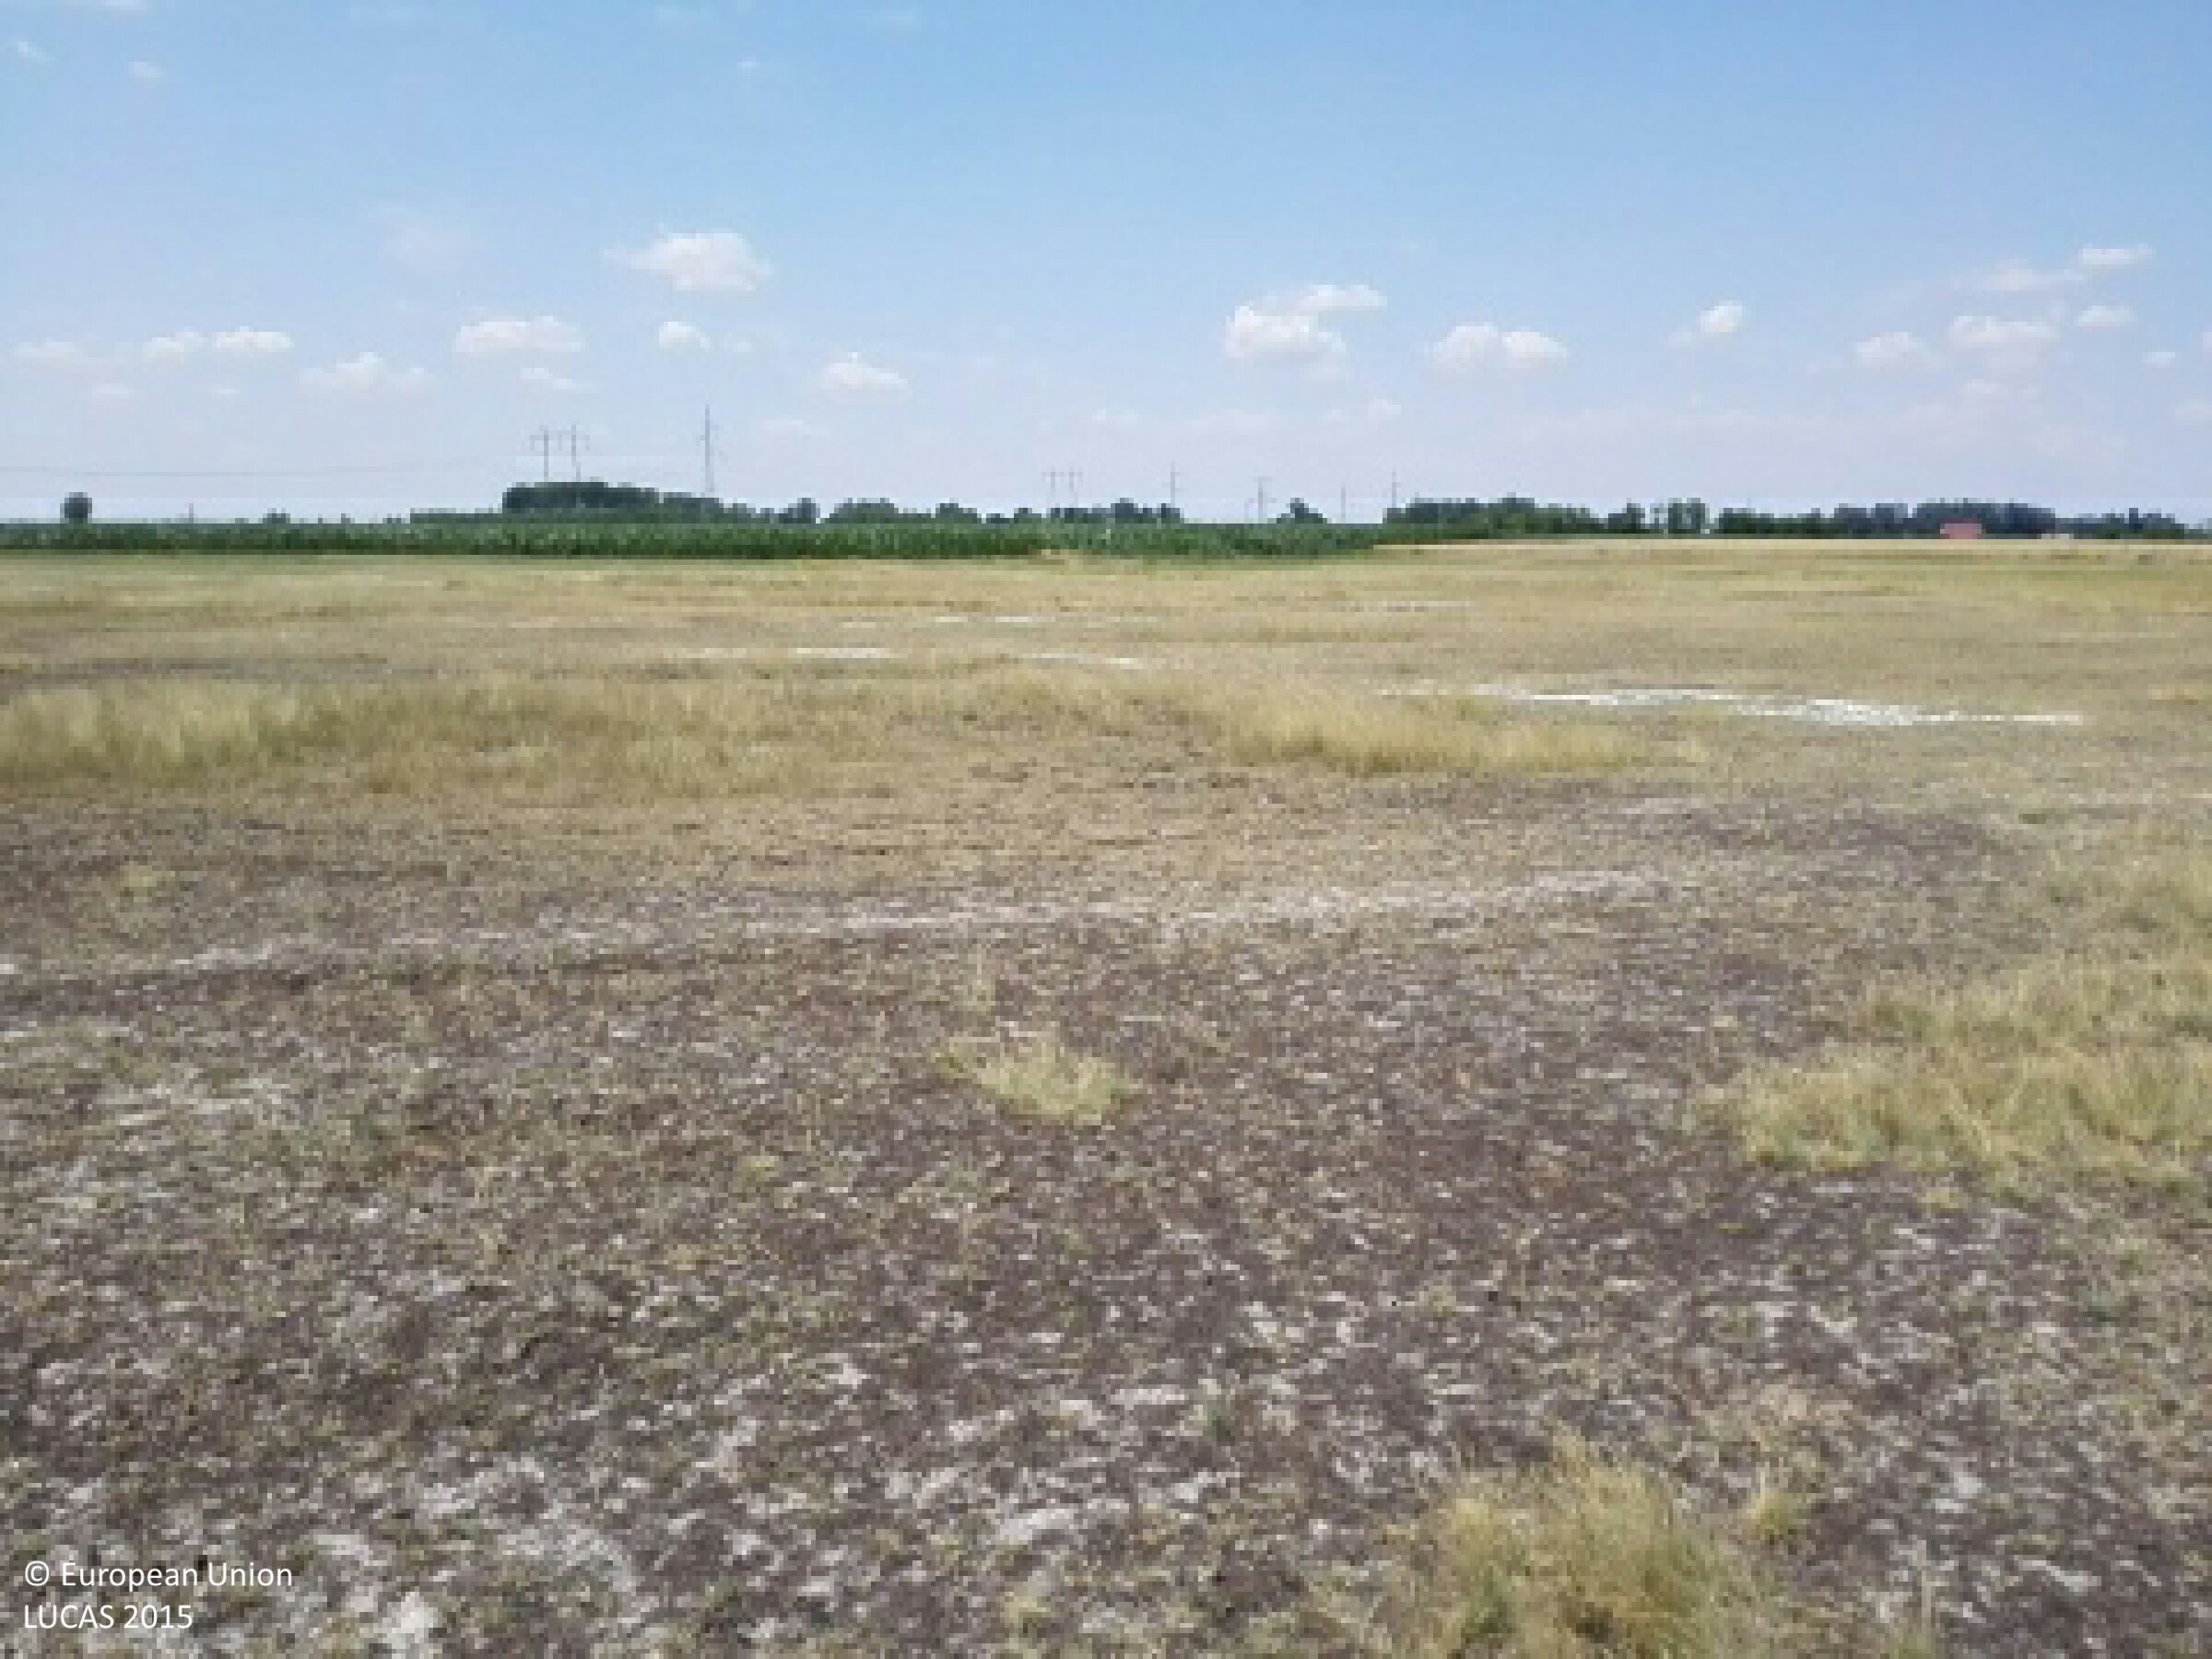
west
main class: Grassland
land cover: Grassland without tree/shrub cover
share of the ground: 25 - 50 %
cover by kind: herbaceous plants 95 %, consolidated bare surface 5 %
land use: Agriculture (excluding fallow land and kitchen gardens)
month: July
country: HU
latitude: 47.7045
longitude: 21.3835
